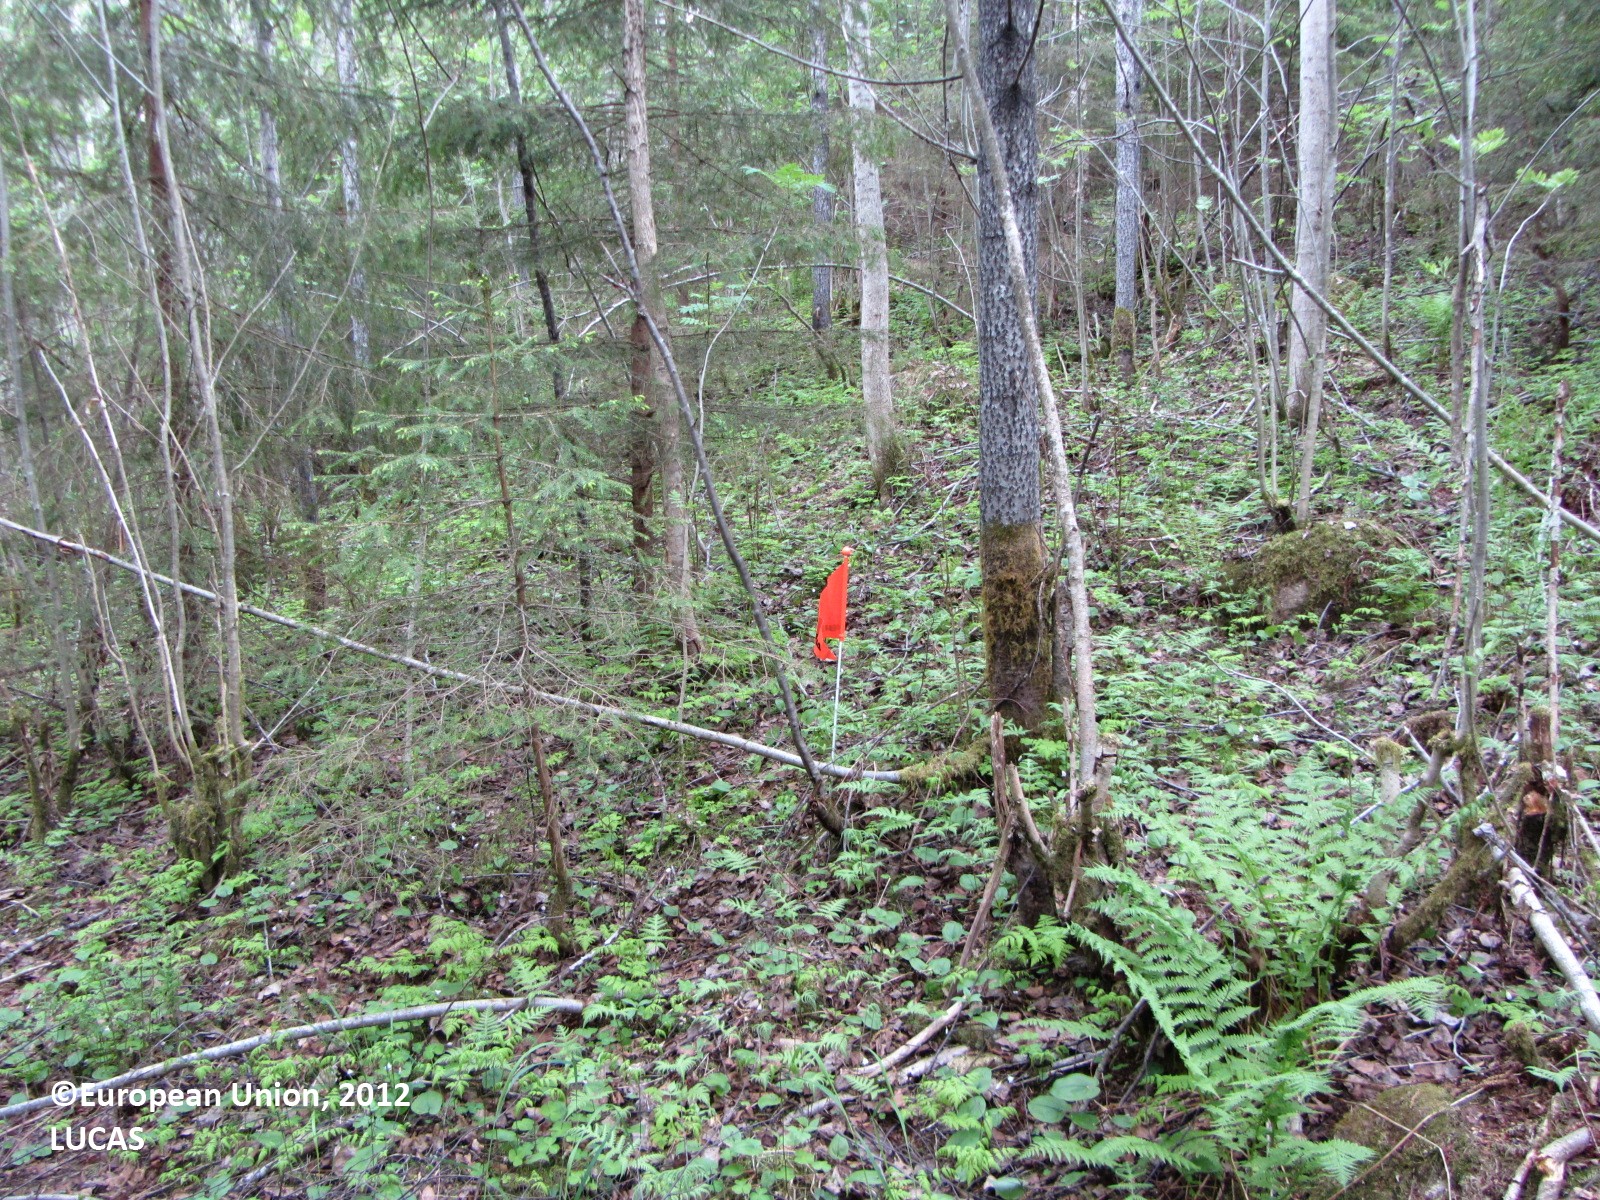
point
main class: Woodland
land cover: Spruce dominated mixed woodland
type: boreal forest
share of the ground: > 75 %
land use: Forestry
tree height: > 5 m
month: May
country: FI
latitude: 62.2788
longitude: 25.3530
